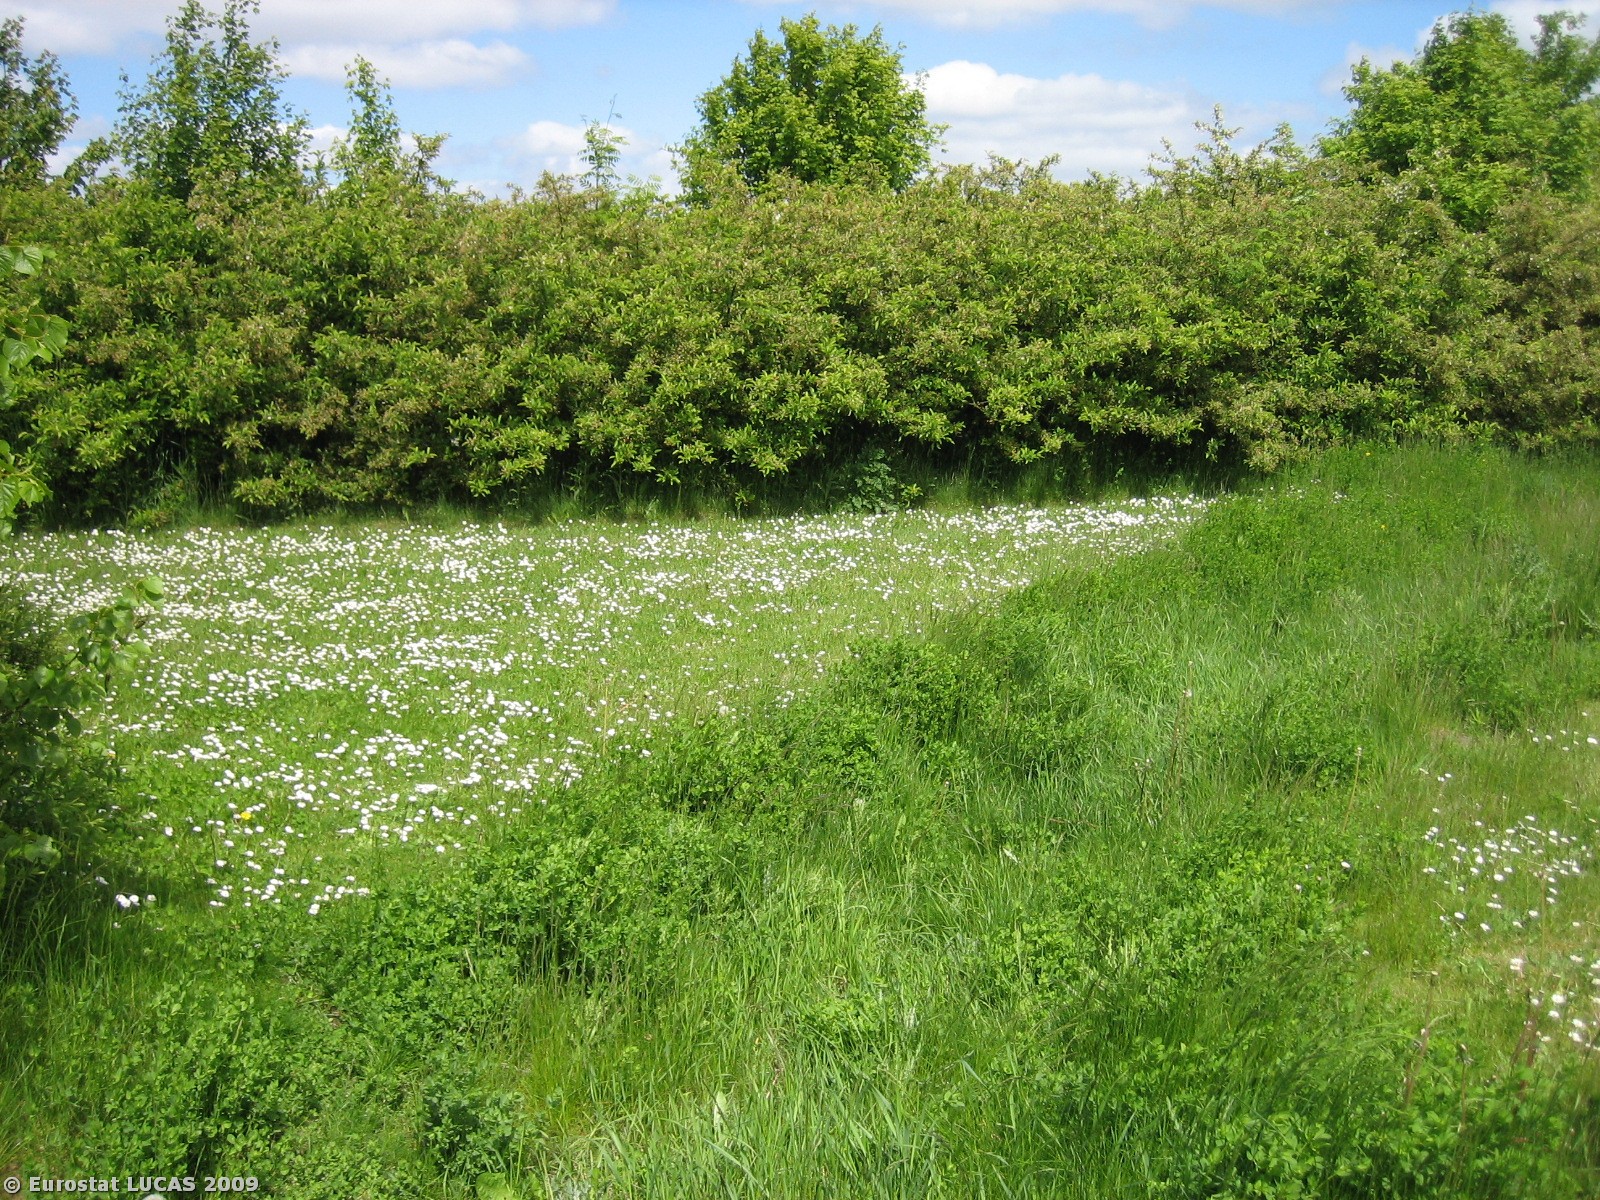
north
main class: Shrubland
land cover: Shrubland with sparse tree cover
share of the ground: > 75 %
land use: Amenities, museums, leisure
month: May
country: DK
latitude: 56.1118
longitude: 8.9880
